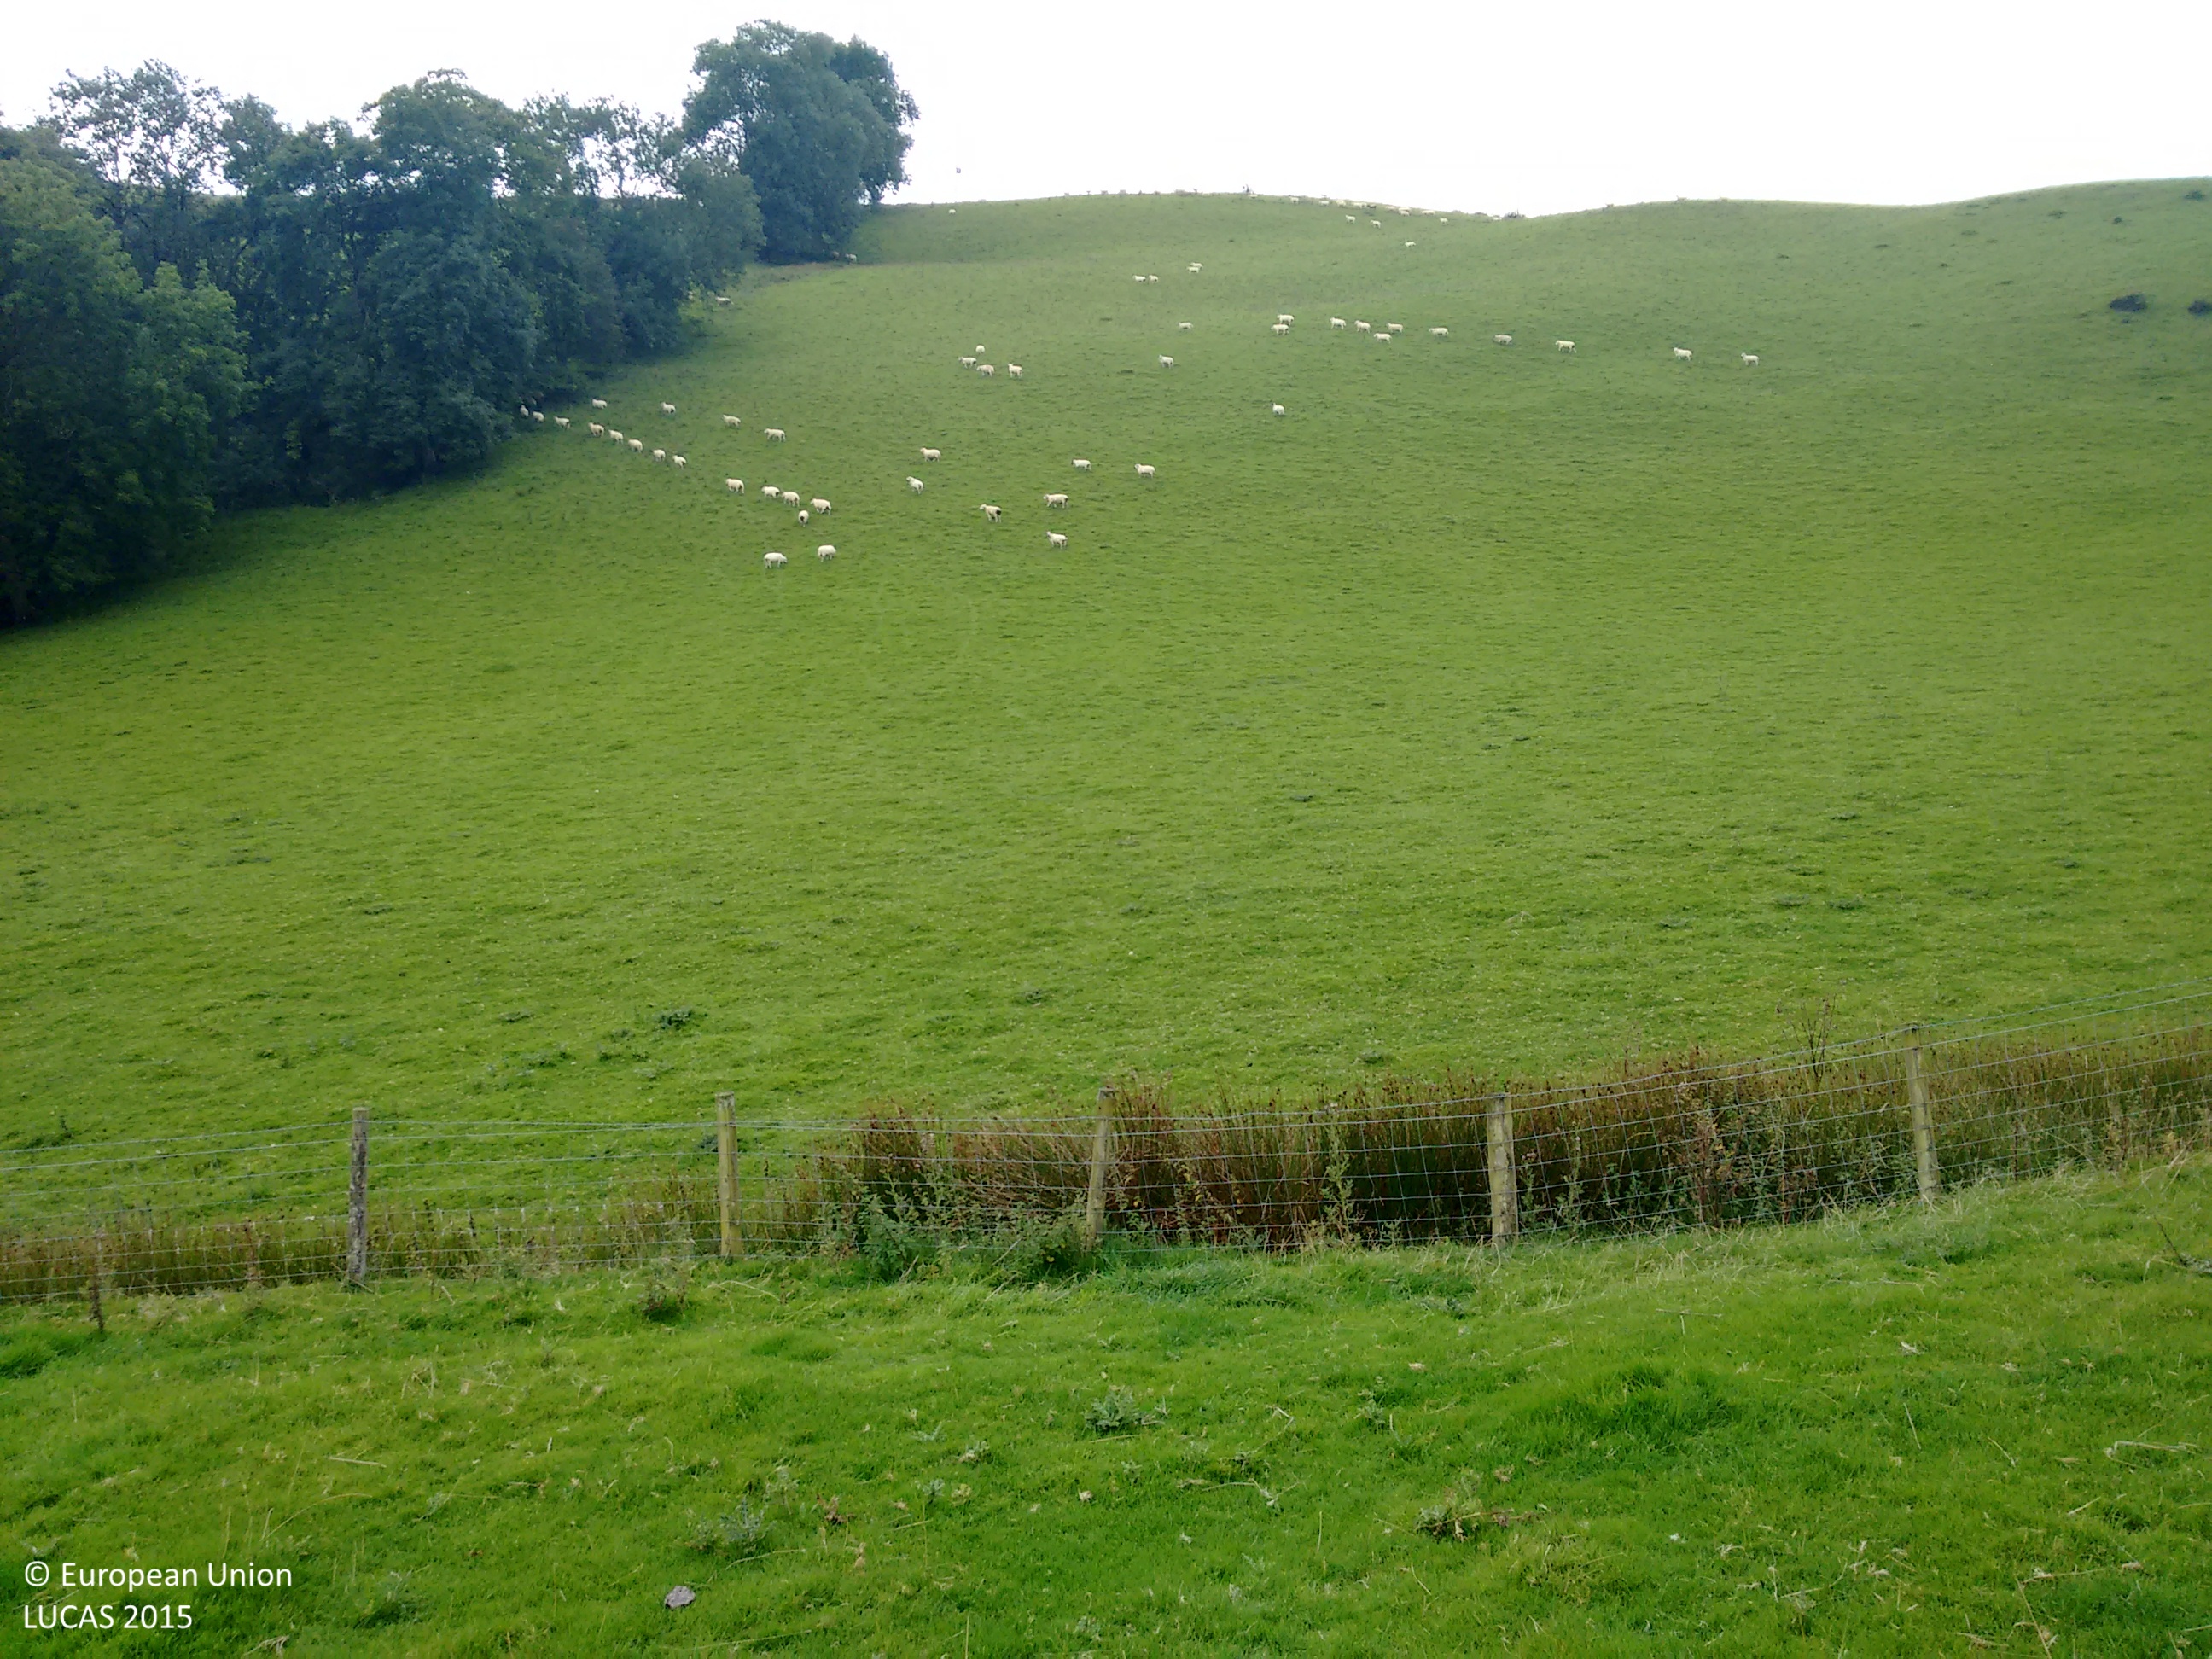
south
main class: Grassland
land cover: Grassland without tree/shrub cover
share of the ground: > 75 %
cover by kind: herbaceous plants 100 %
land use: Agriculture (excluding fallow land and kitchen gardens)
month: September
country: GB
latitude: 52.7538
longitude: -3.3116
